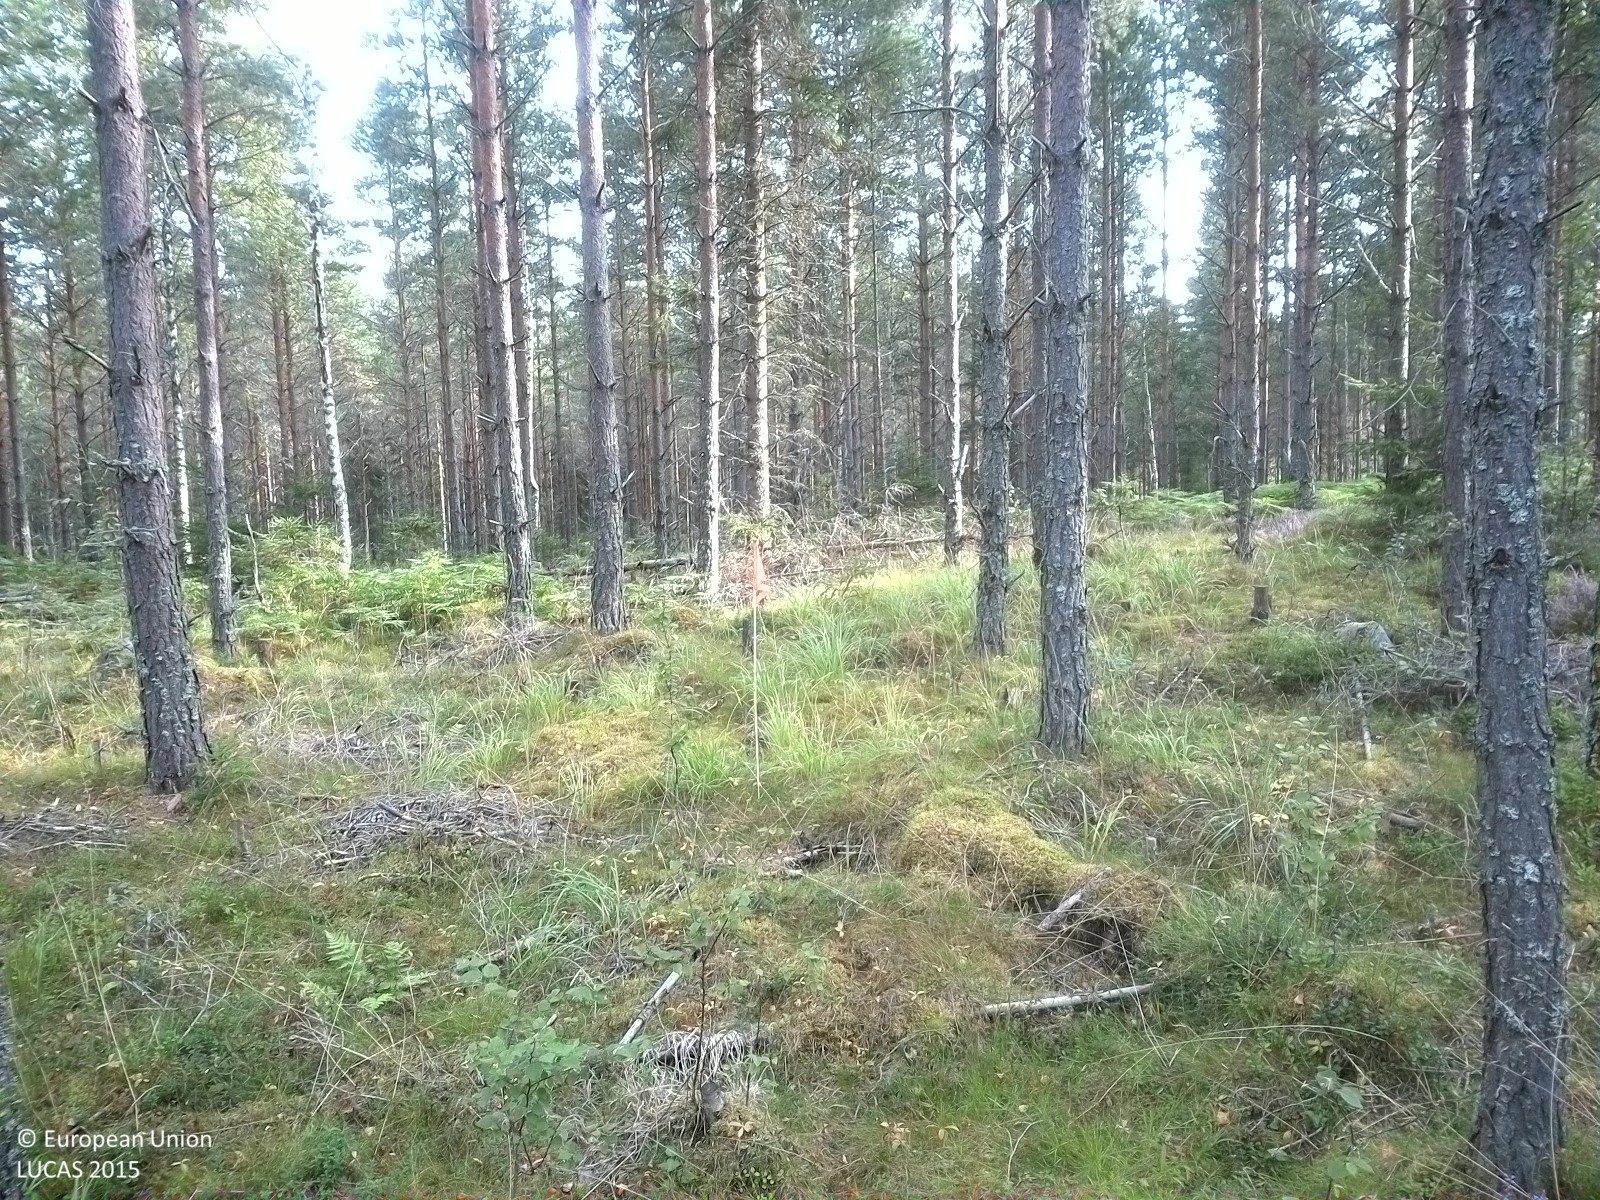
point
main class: Woodland
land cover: Pine dominated coniferous woodland
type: boreal forest
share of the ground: 25 - 50 %
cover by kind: herbaceous plants 35 %, coniferous forest trees 30 %, lichens and mosses 20 %, shrubs 10 %, broadleaved forest trees 5 %
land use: Forestry
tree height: > 5 m
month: August
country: SE
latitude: 58.8291
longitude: 15.4841
